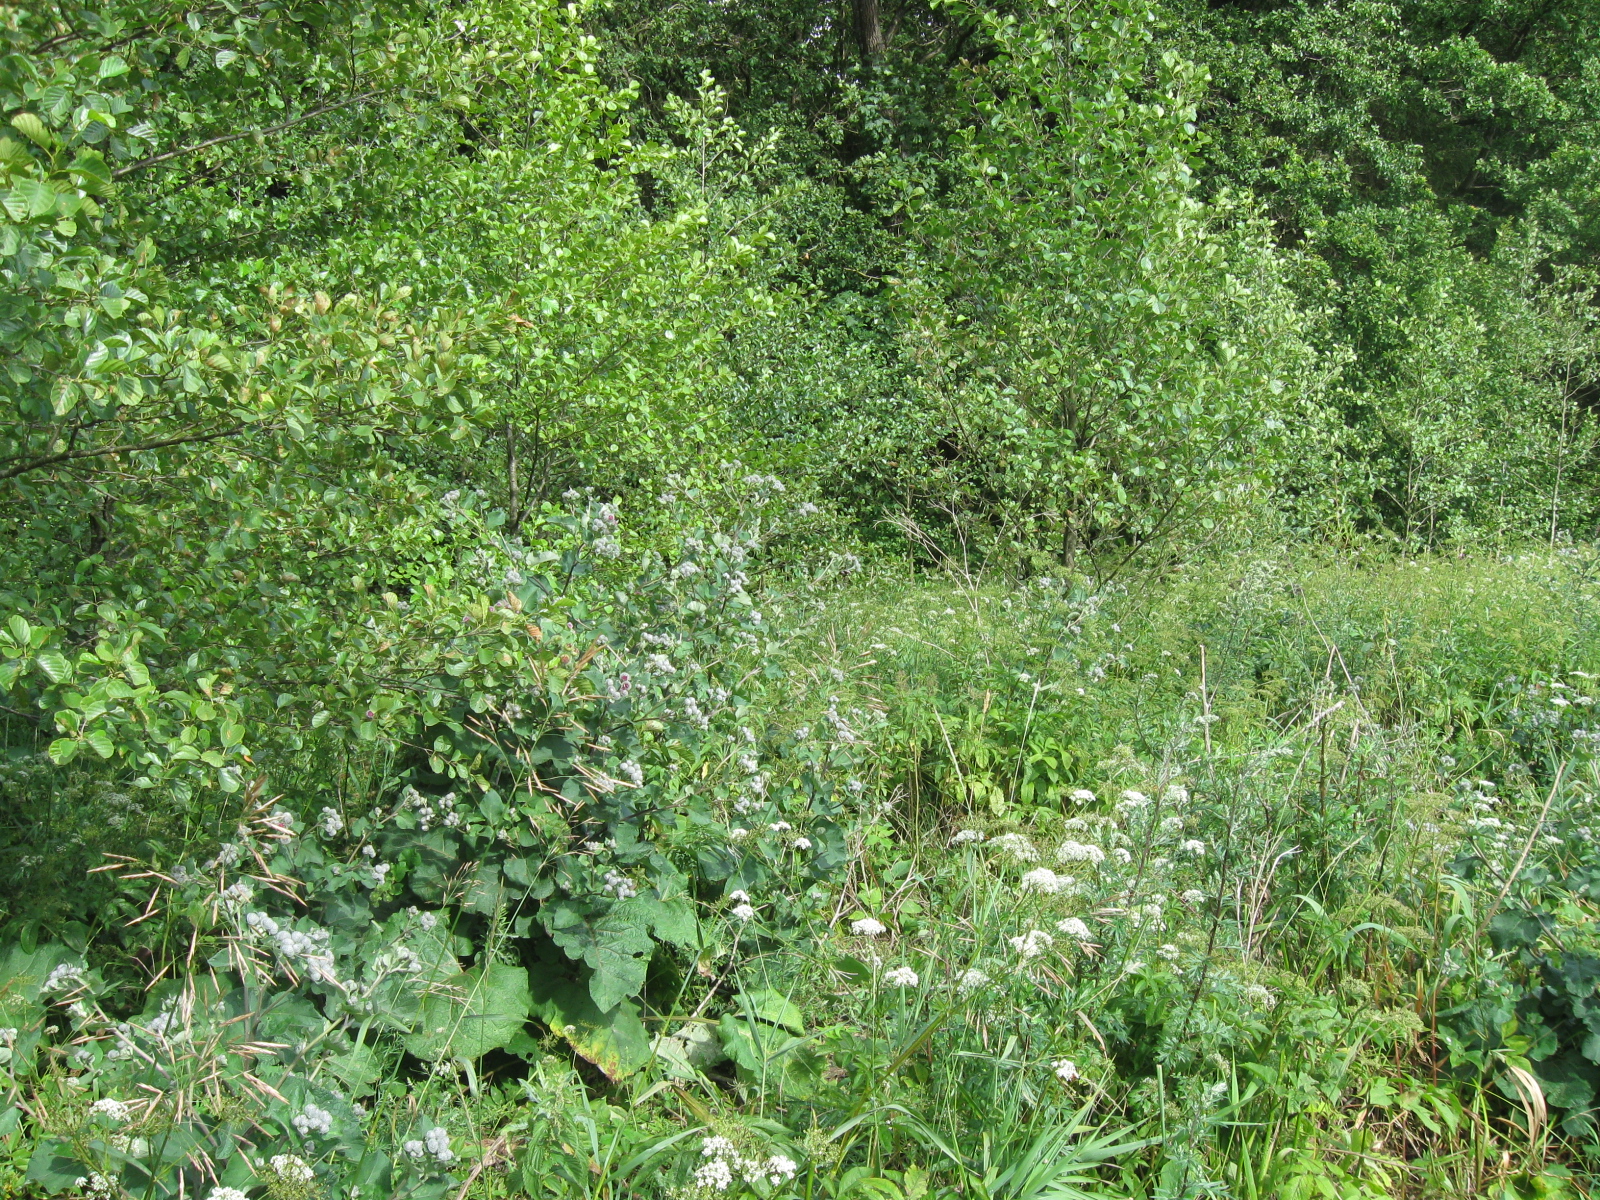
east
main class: Grassland
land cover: Grassland without tree/shrub cover
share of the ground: > 75 %
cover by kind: herbaceous plants 100 %
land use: Agriculture (excluding fallow land and kitchen gardens)
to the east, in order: Grassland without tree/shrub cover; Spontaneously vegetated surfaces; Inland fresh running water; Spontaneously vegetated surfaces; Tracks; Spontaneously vegetated surfaces; Broadleaved woodland; Spruce dominated mixed woodland; Spontaneously vegetated surfaces; Spruce dominated mixed woodland
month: July
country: LT
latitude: 54.3075
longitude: 24.2530
